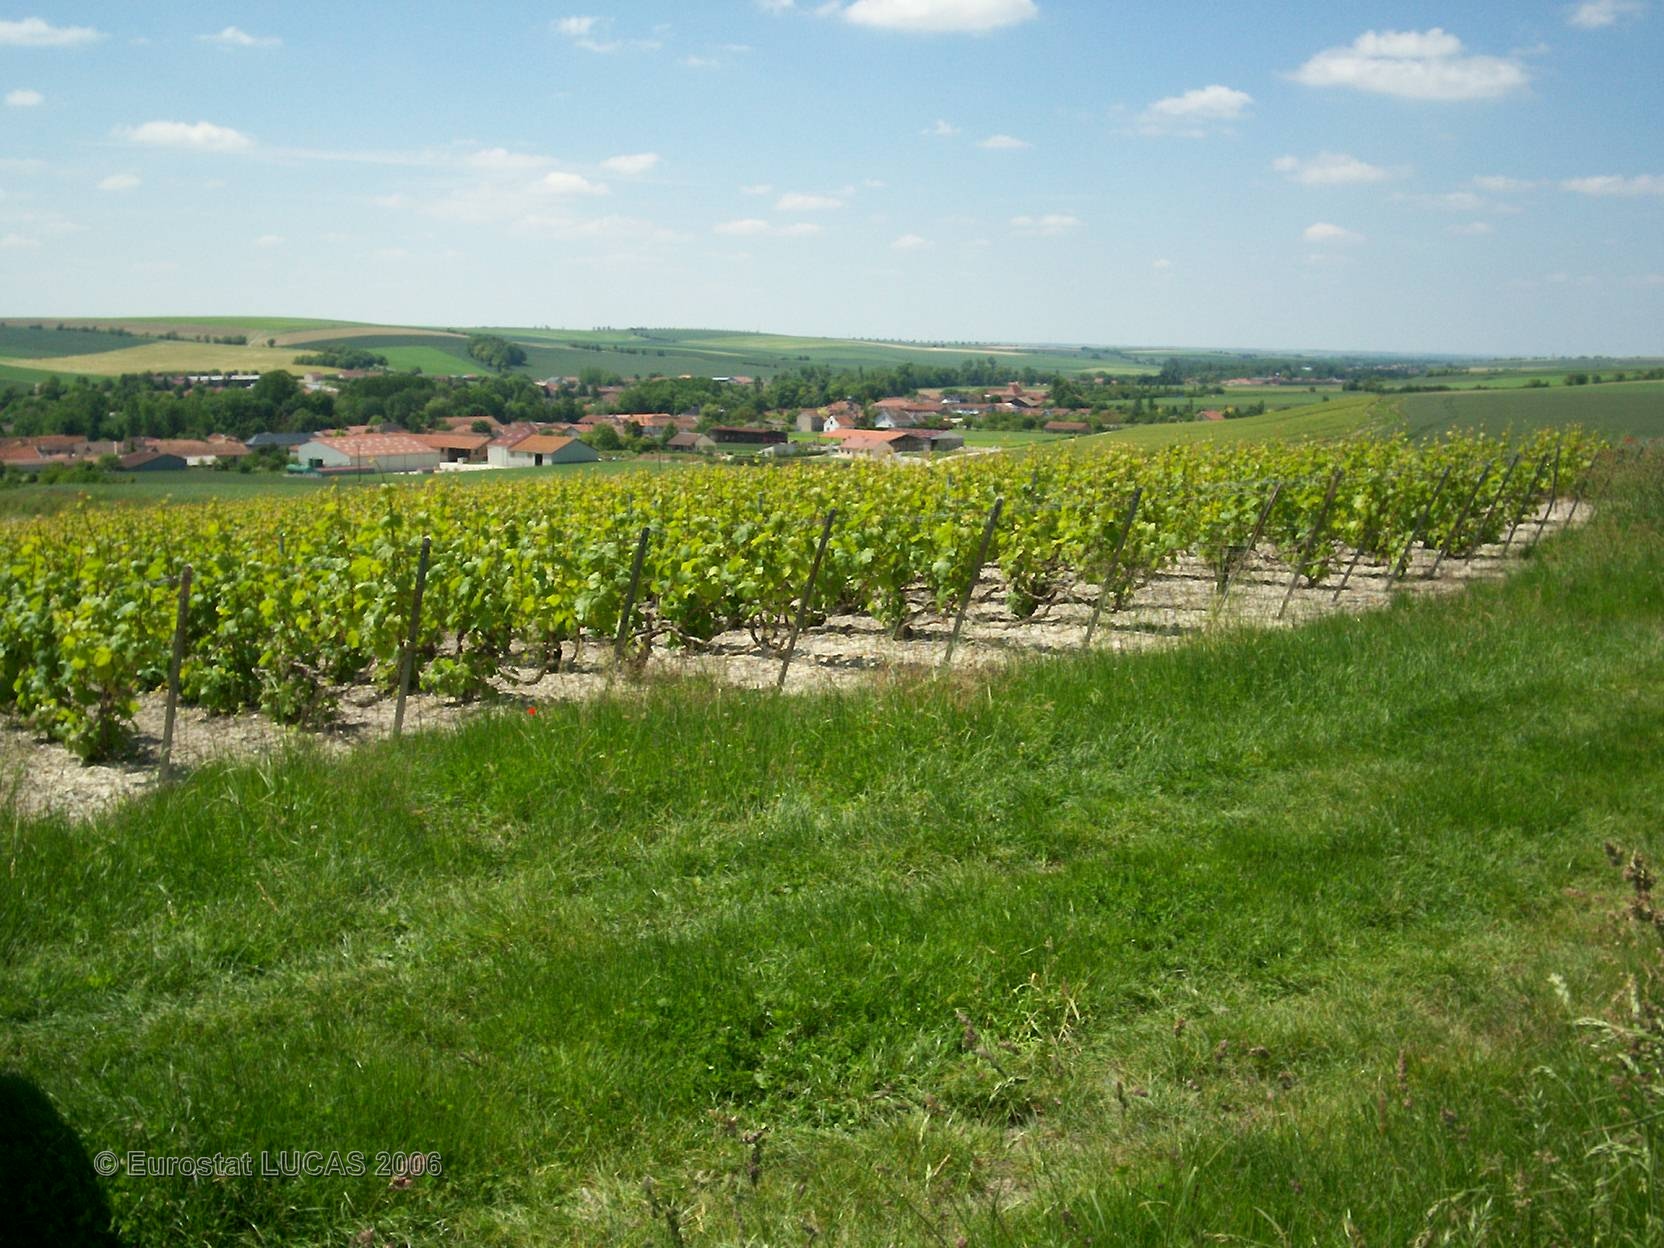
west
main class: Cropland
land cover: Common wheat
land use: Agriculture (excluding fallow land and kitchen gardens)
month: June
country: FR
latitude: 48.8134
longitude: 4.6181
